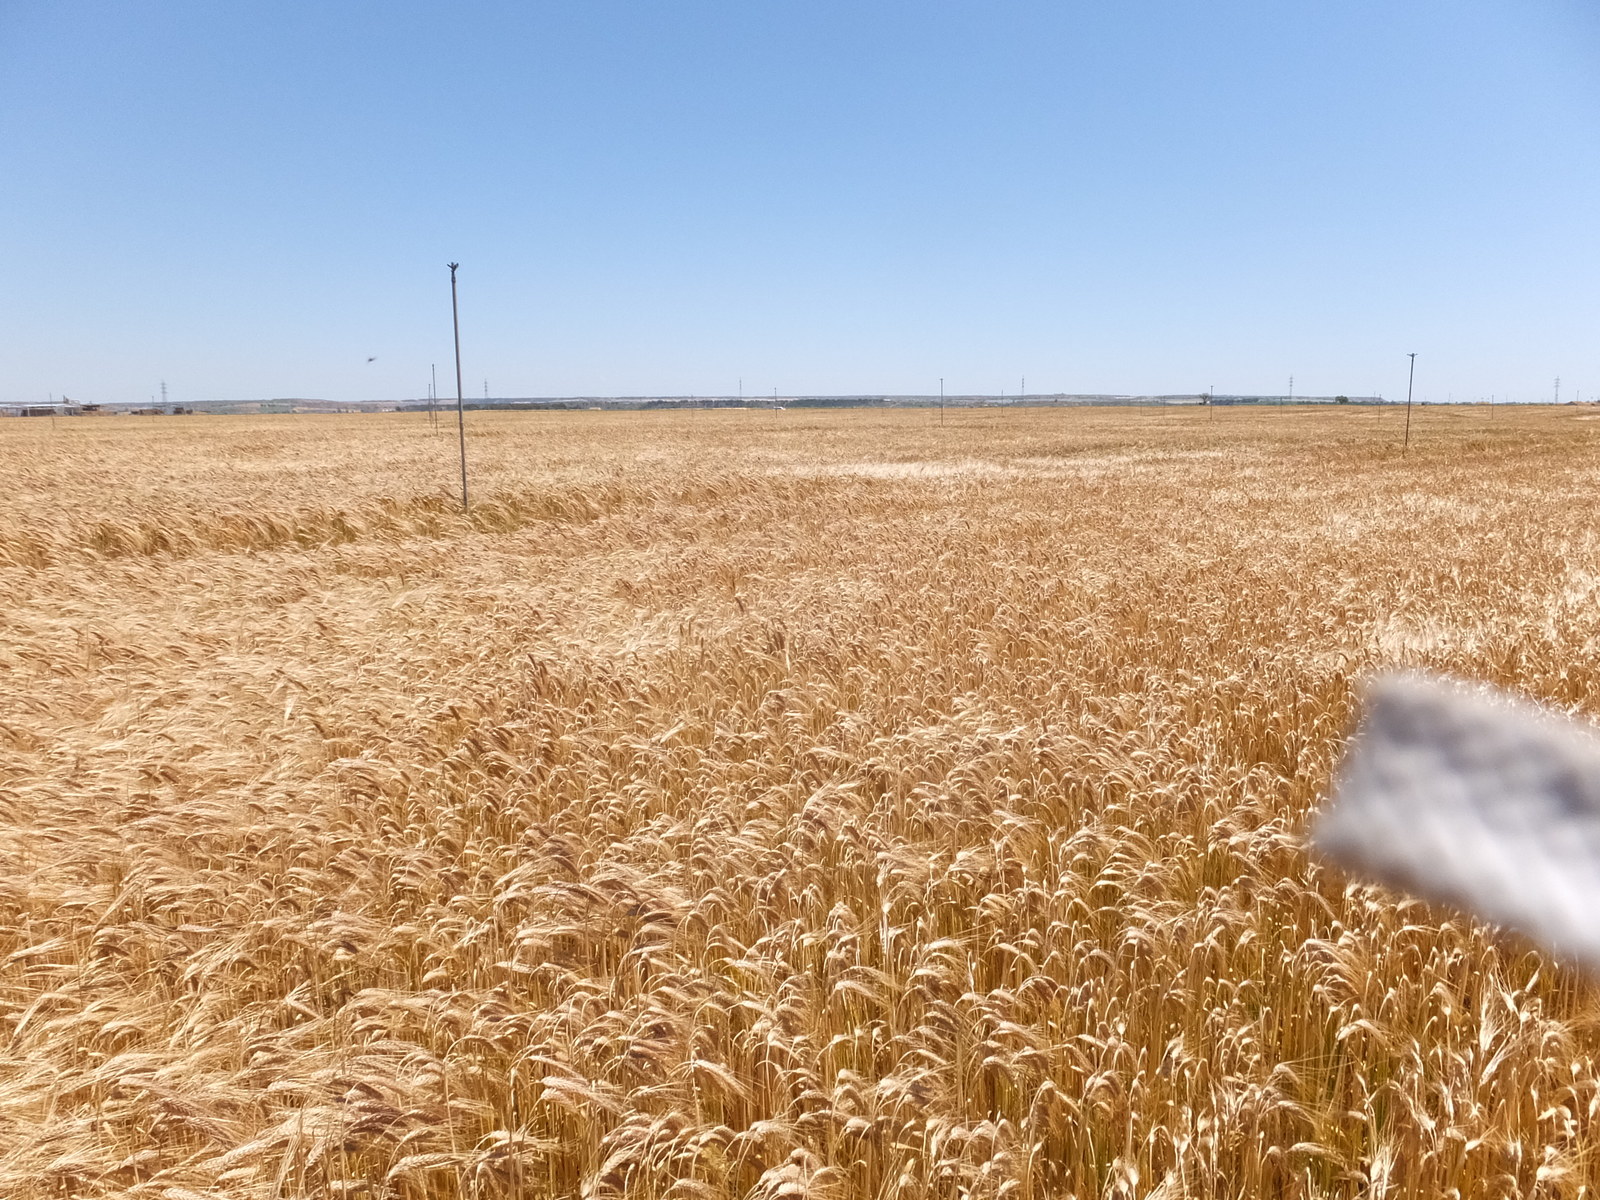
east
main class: Cropland
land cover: Barley
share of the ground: > 75 %
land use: Agriculture (excluding fallow land and kitchen gardens)
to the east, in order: Barley
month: May
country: ES
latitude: 41.8293
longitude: -0.1929
